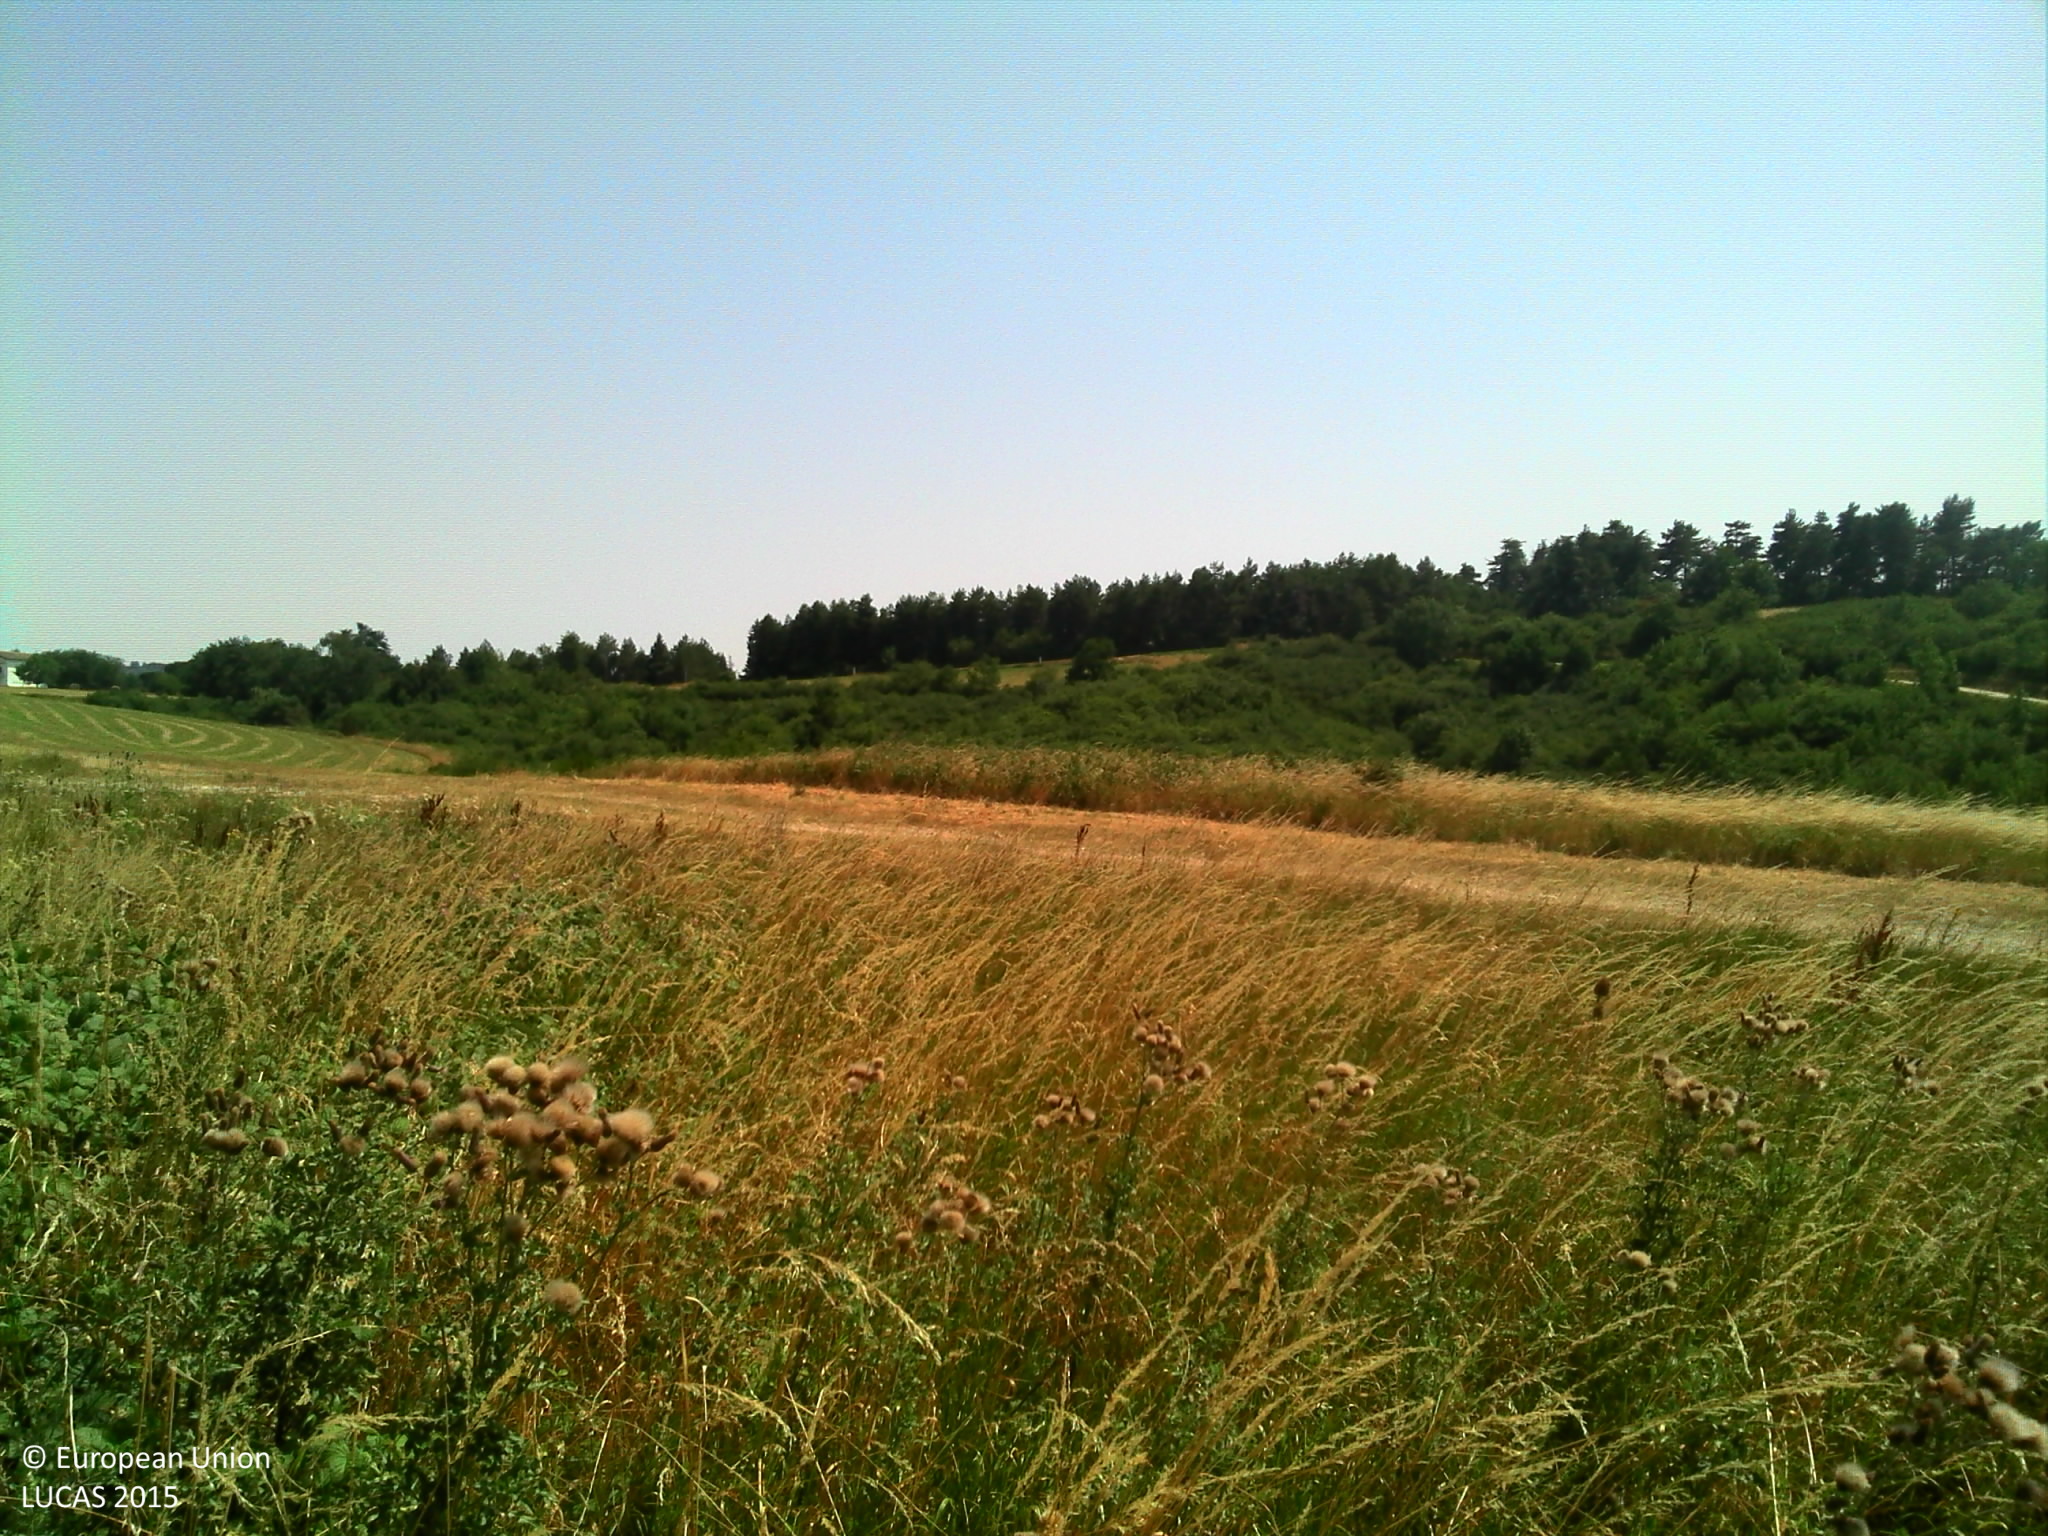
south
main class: Shrubland
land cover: Shrubland with sparse tree cover
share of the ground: > 75 %
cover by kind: shrubs 65 %, herbaceous plants 30 %, broadleaved forest trees 5 %
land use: Semi-natural and natural areas not in use
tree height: < 5 m
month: July
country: FR
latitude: 43.4442
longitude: 2.0114
